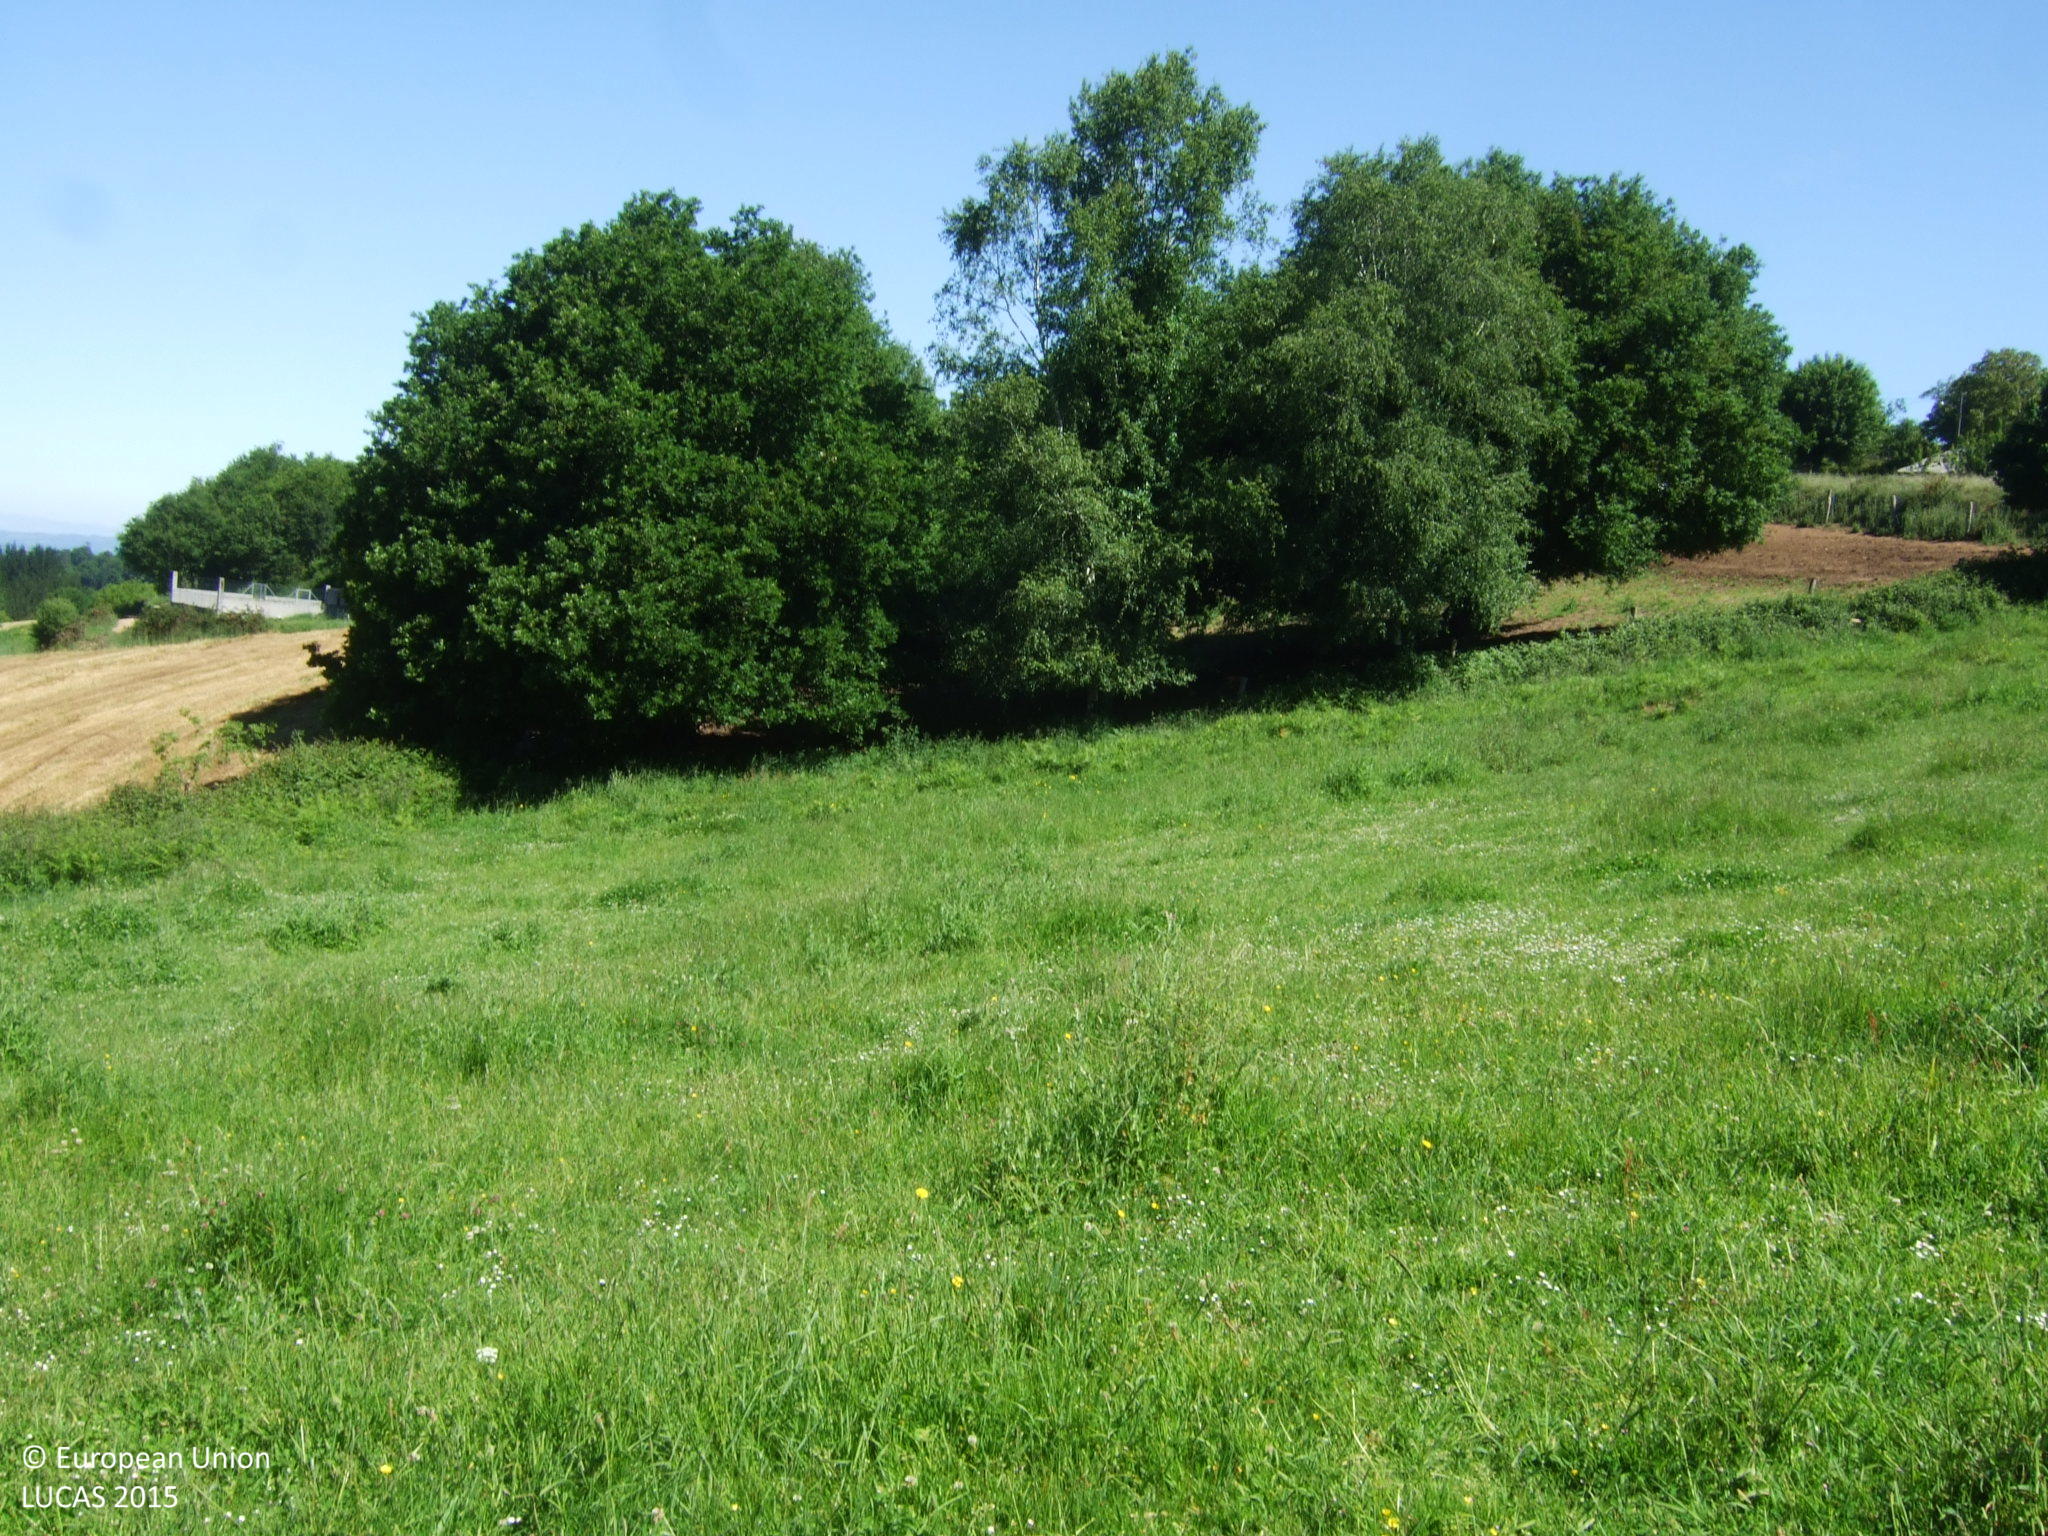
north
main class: Grassland
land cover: Grassland without tree/shrub cover
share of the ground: > 75 %
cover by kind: herbaceous plants 100 %
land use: Agriculture (excluding fallow land and kitchen gardens)
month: May
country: ES
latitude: 42.7430
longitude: -7.5799
